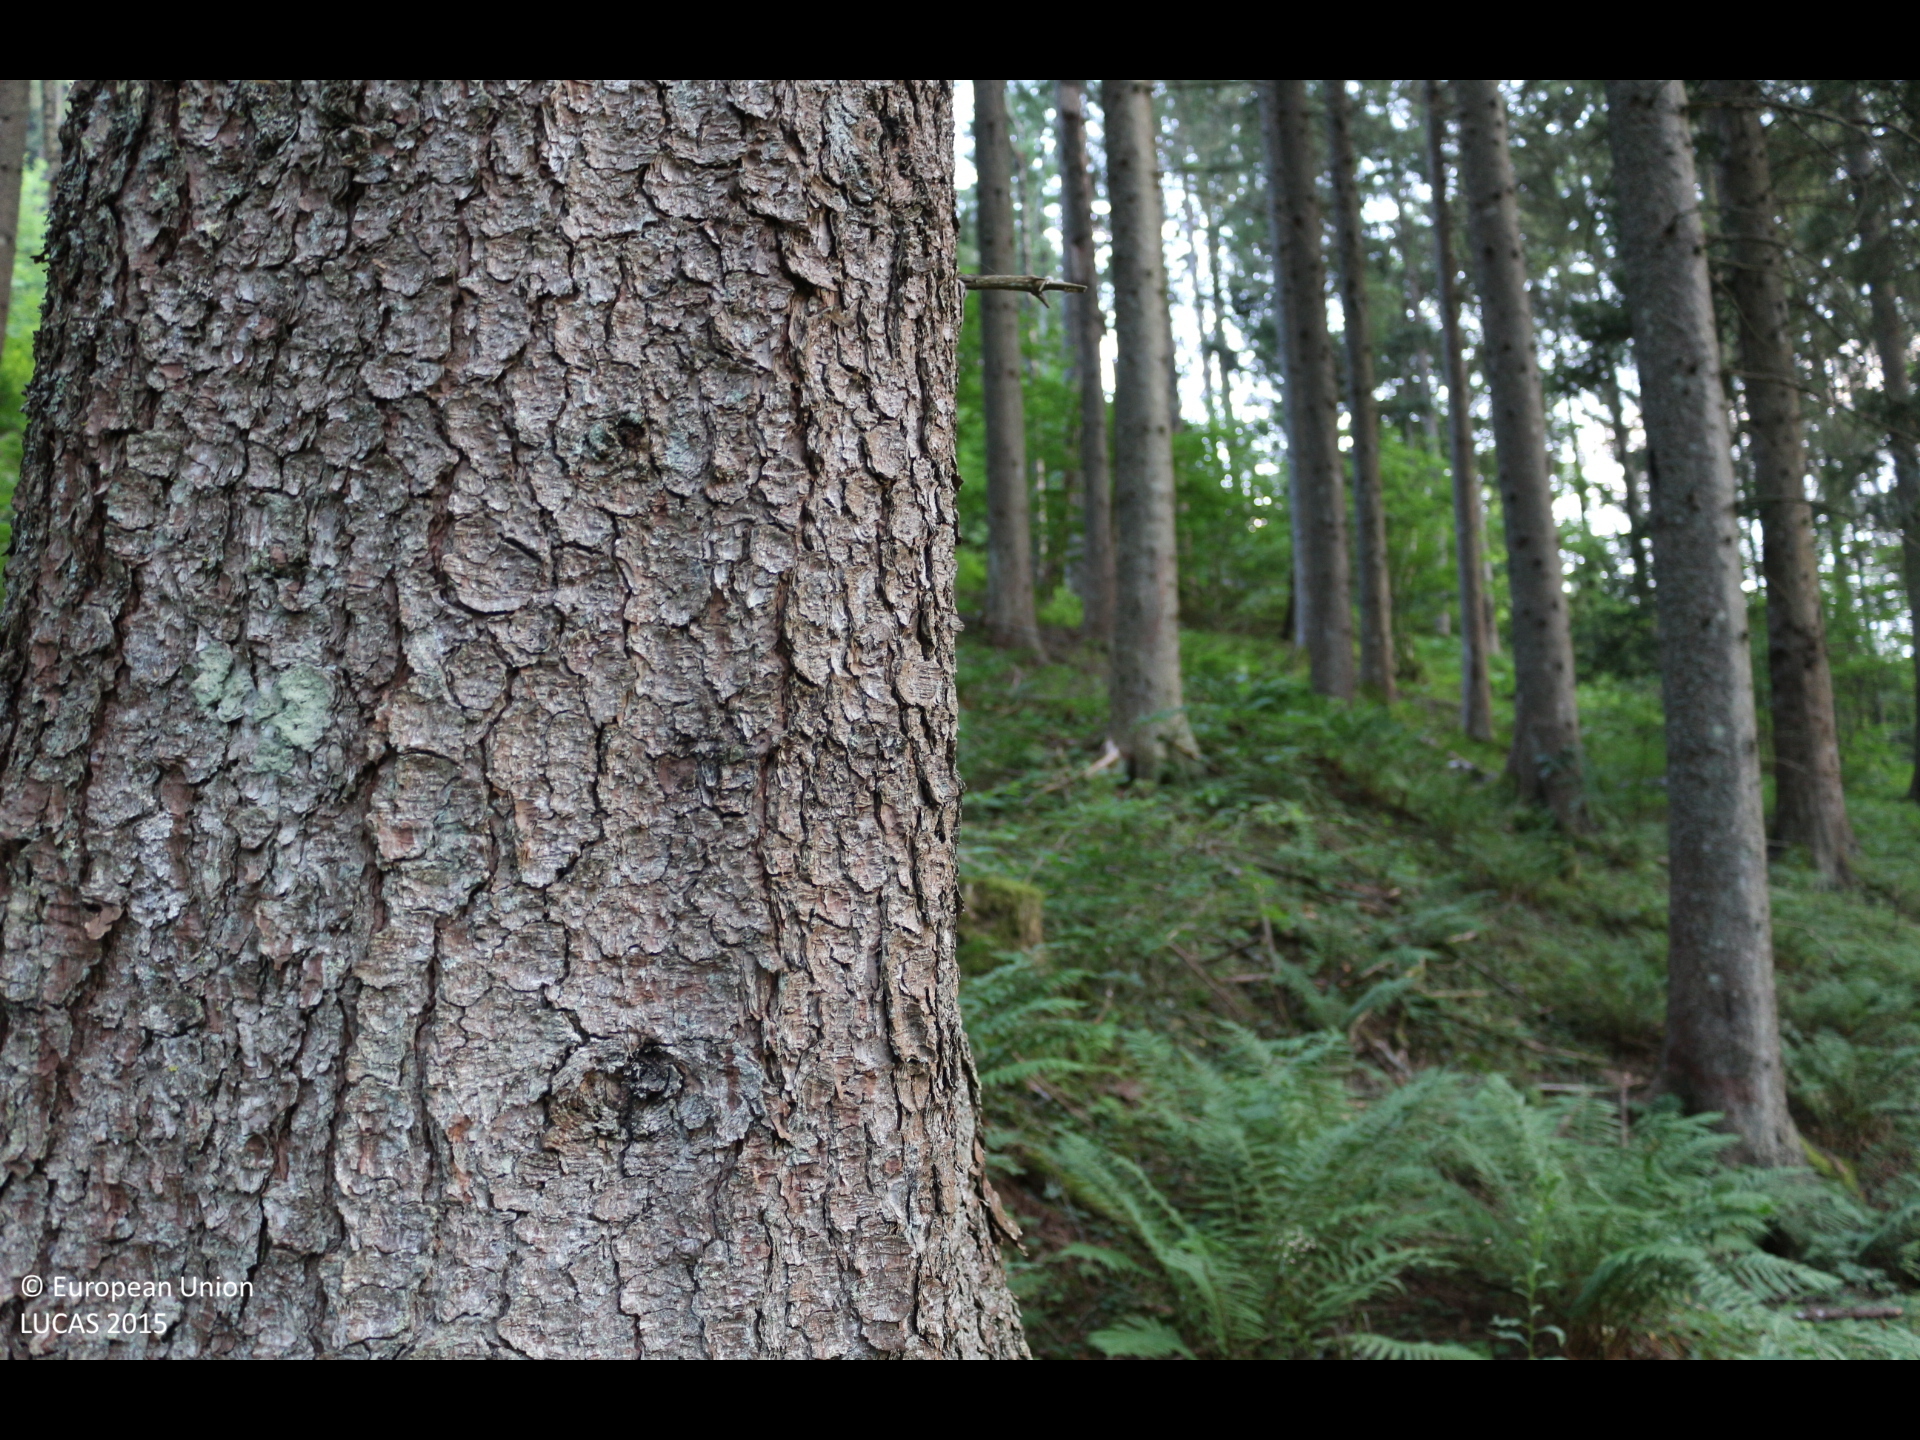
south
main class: Woodland
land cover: Spruce dominated coniferous woodland
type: alpine coniferous forest
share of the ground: > 75 %
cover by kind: coniferous forest trees 100 %
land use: Forestry
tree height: > 5 m
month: July
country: AT
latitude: 46.7936
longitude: 14.1506
